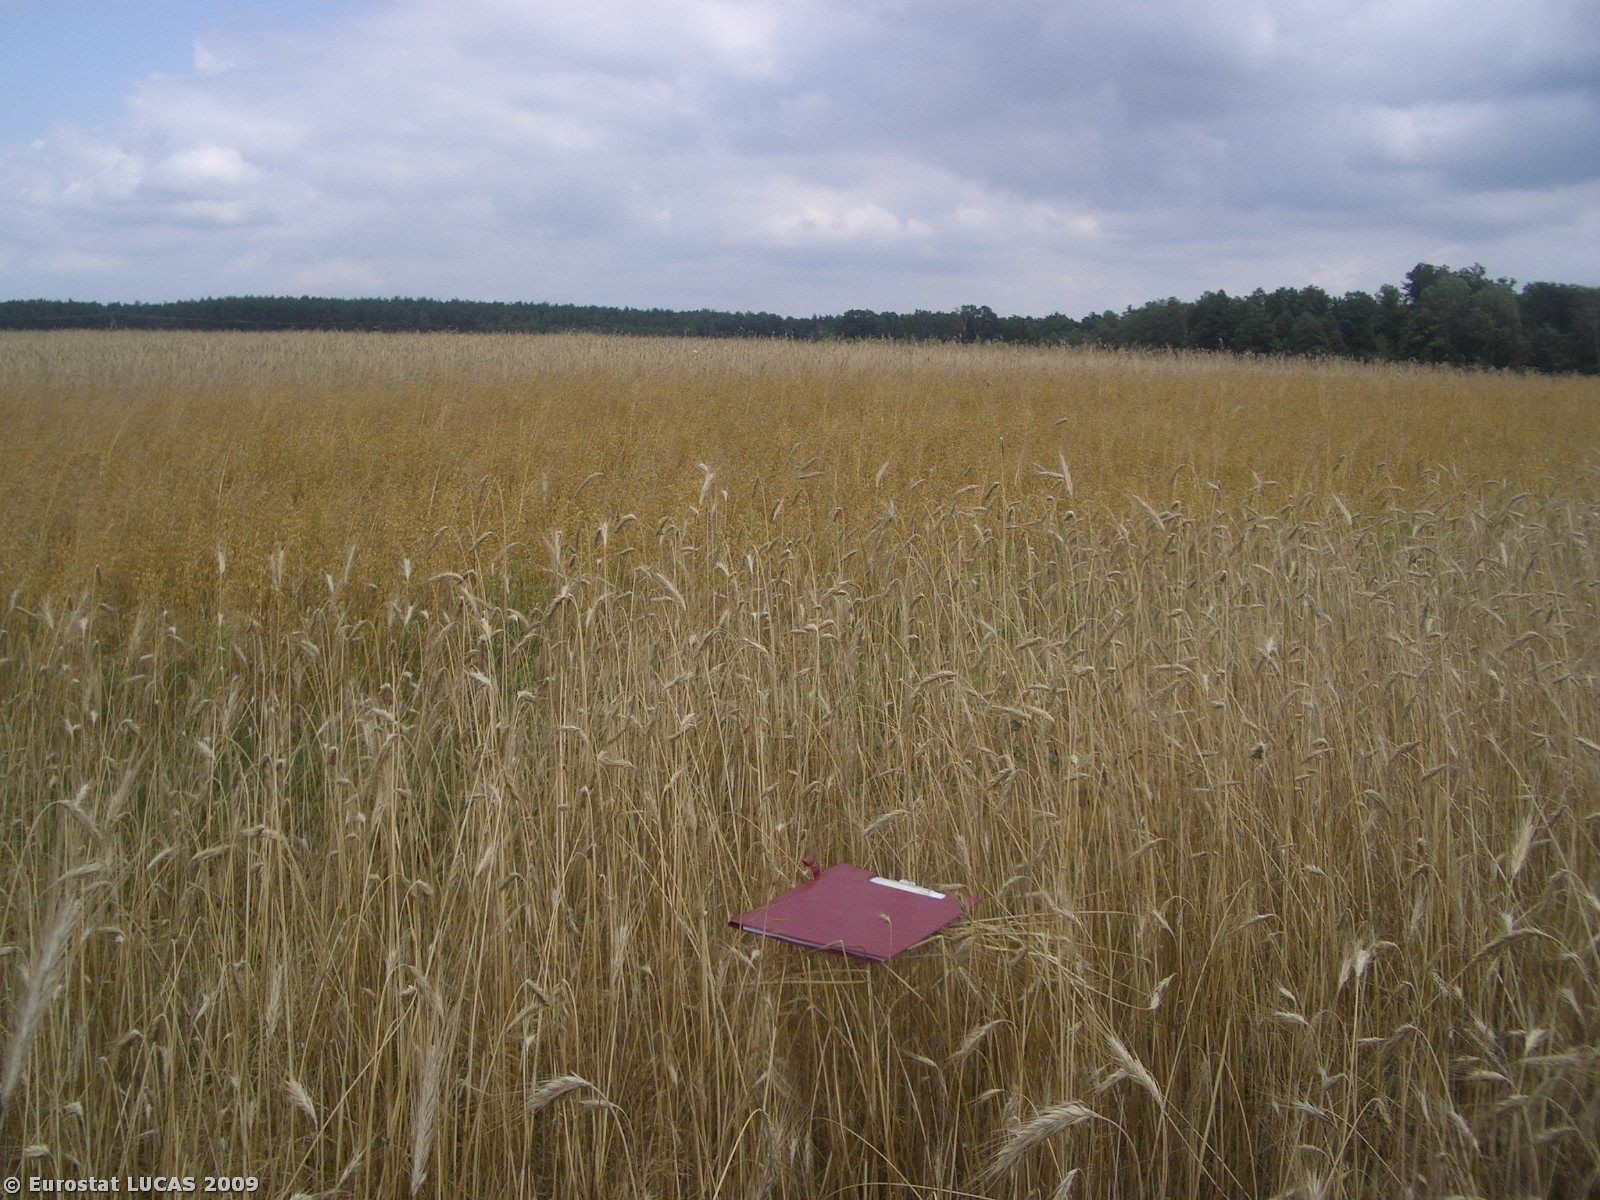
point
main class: Cropland
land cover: Rye
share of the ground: > 75 %
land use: Agriculture (excluding fallow land and kitchen gardens)
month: July
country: PL
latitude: 51.7489
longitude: 22.5090
